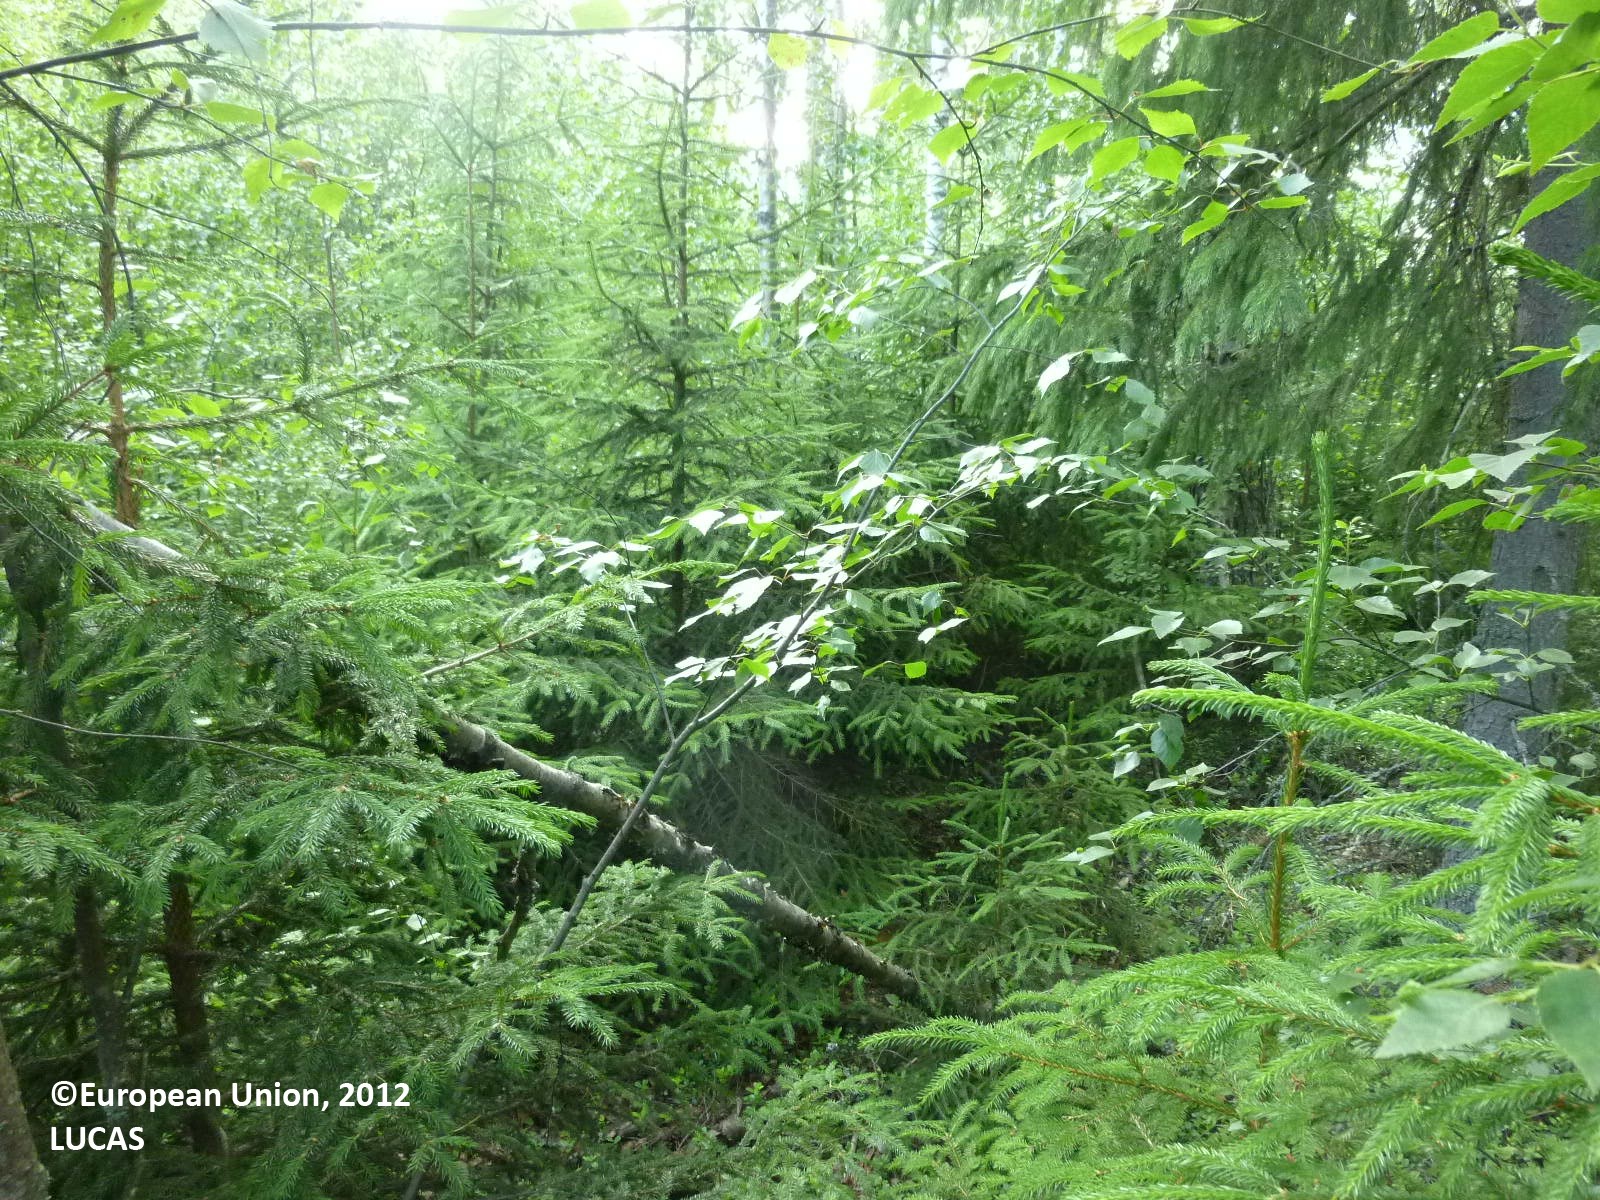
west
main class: Woodland
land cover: Other mixed woodland
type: boreal forest
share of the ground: > 75 %
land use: Forestry
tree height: > 5 m
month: July
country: FI
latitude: 61.3638
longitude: 22.4274
